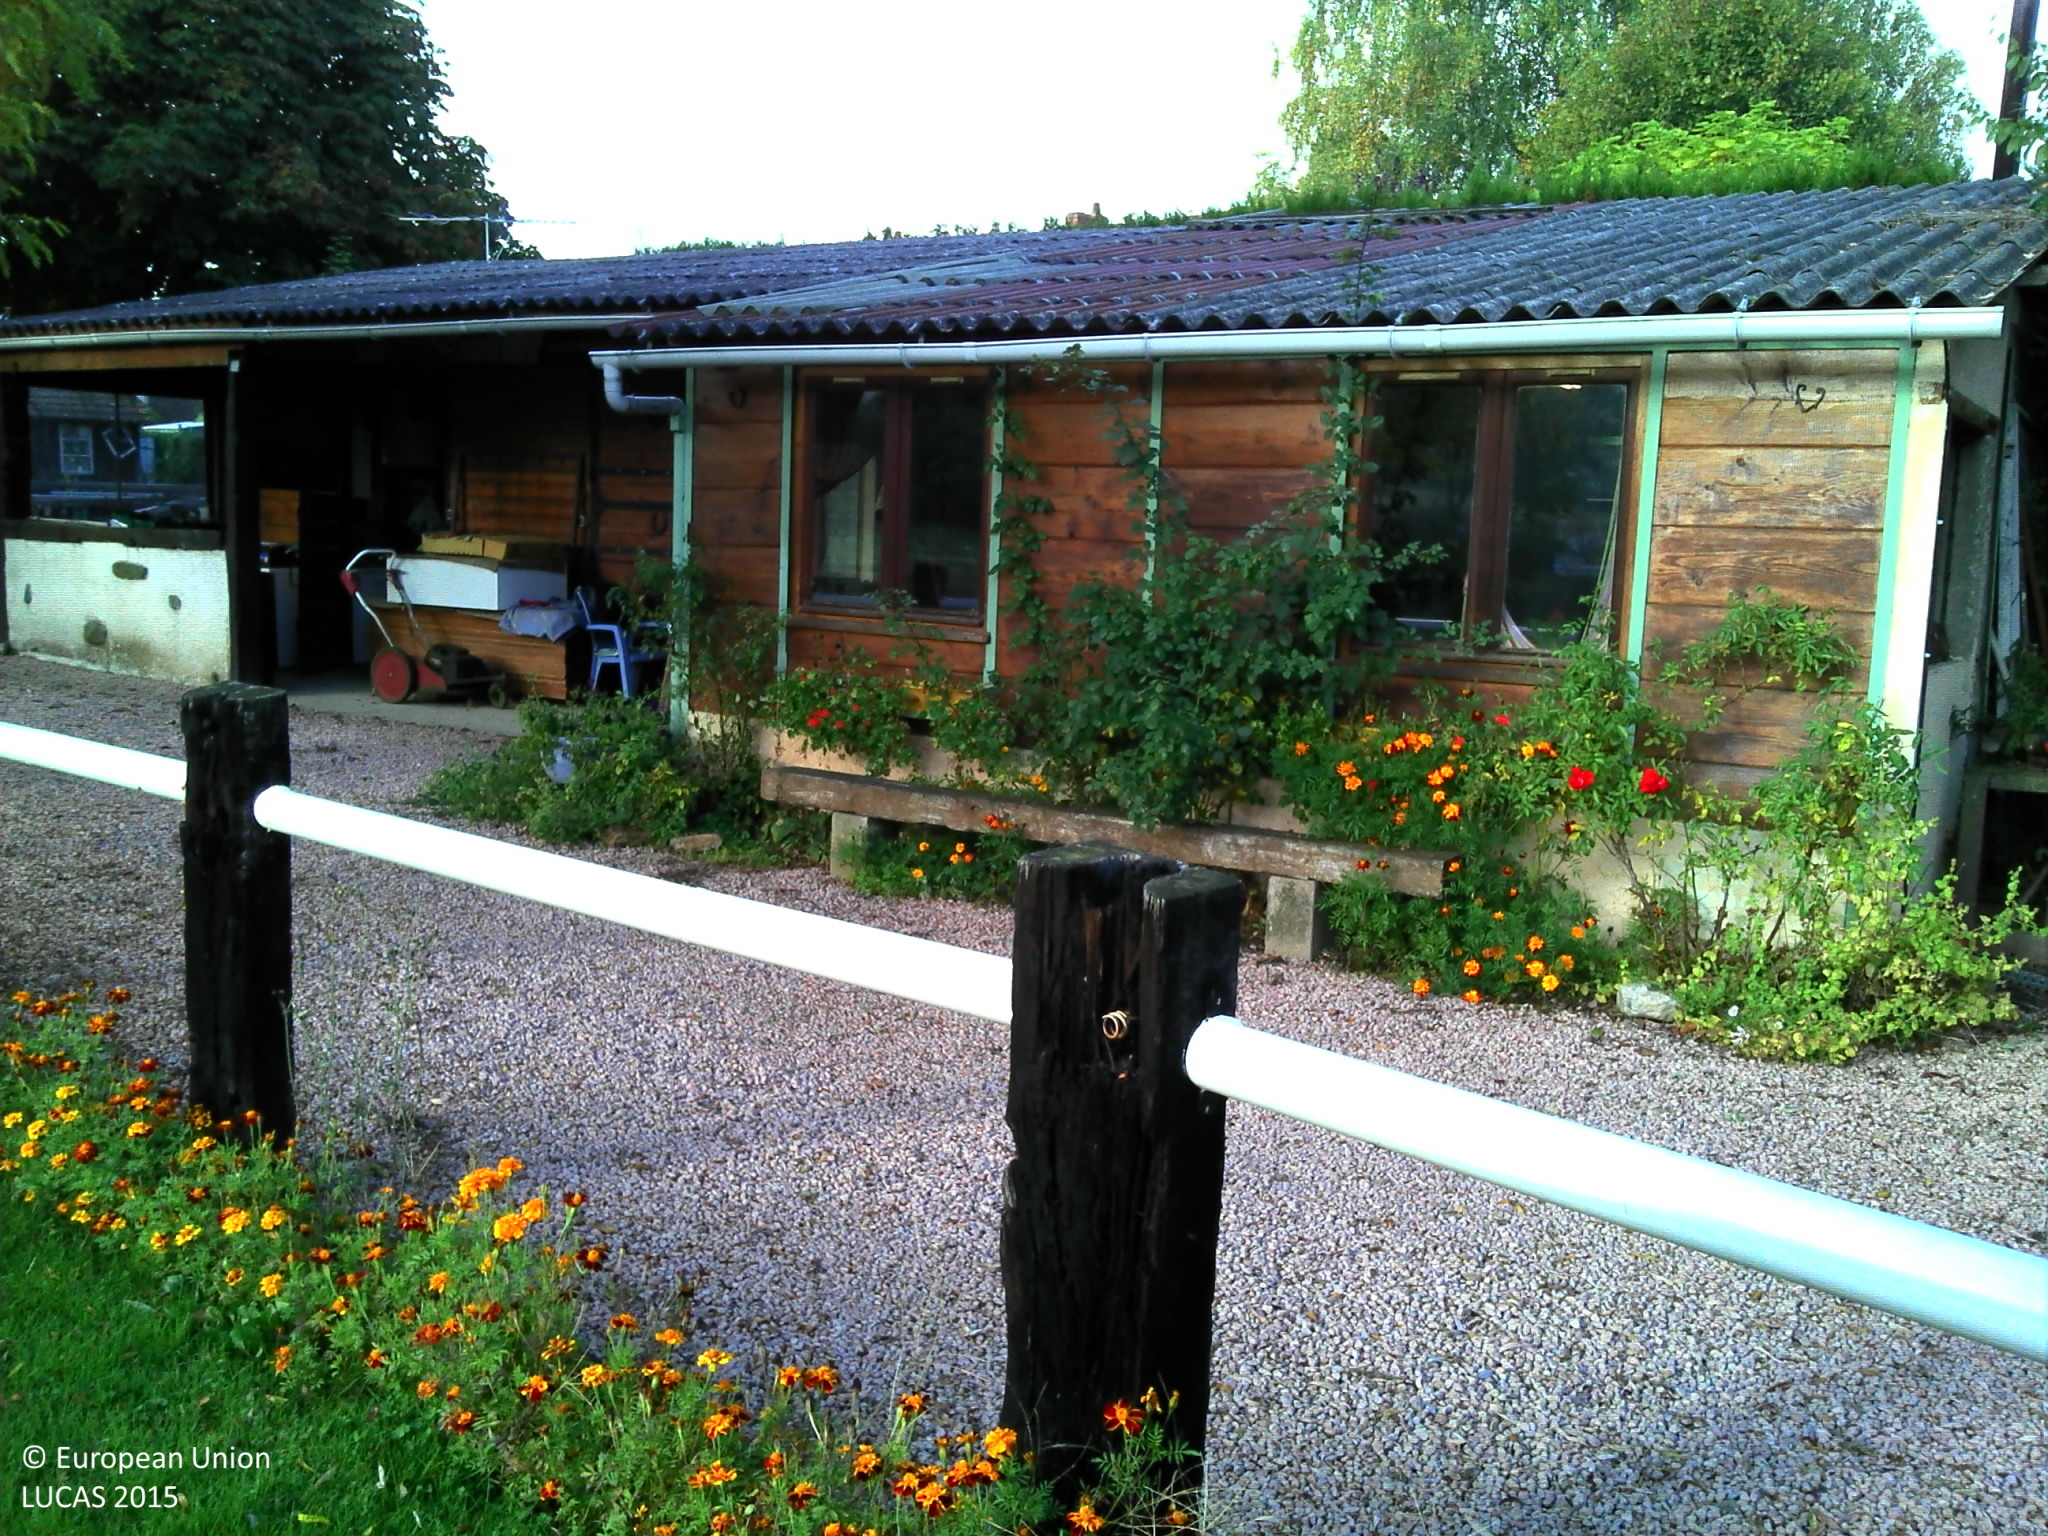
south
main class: Grassland
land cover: Grassland with sparse tree/shrub cover
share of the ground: > 75 %
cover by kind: herbaceous plants 95 %, coniferous forest trees 5 %
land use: Residential
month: October
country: FR
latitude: 46.1275
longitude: 2.8147
